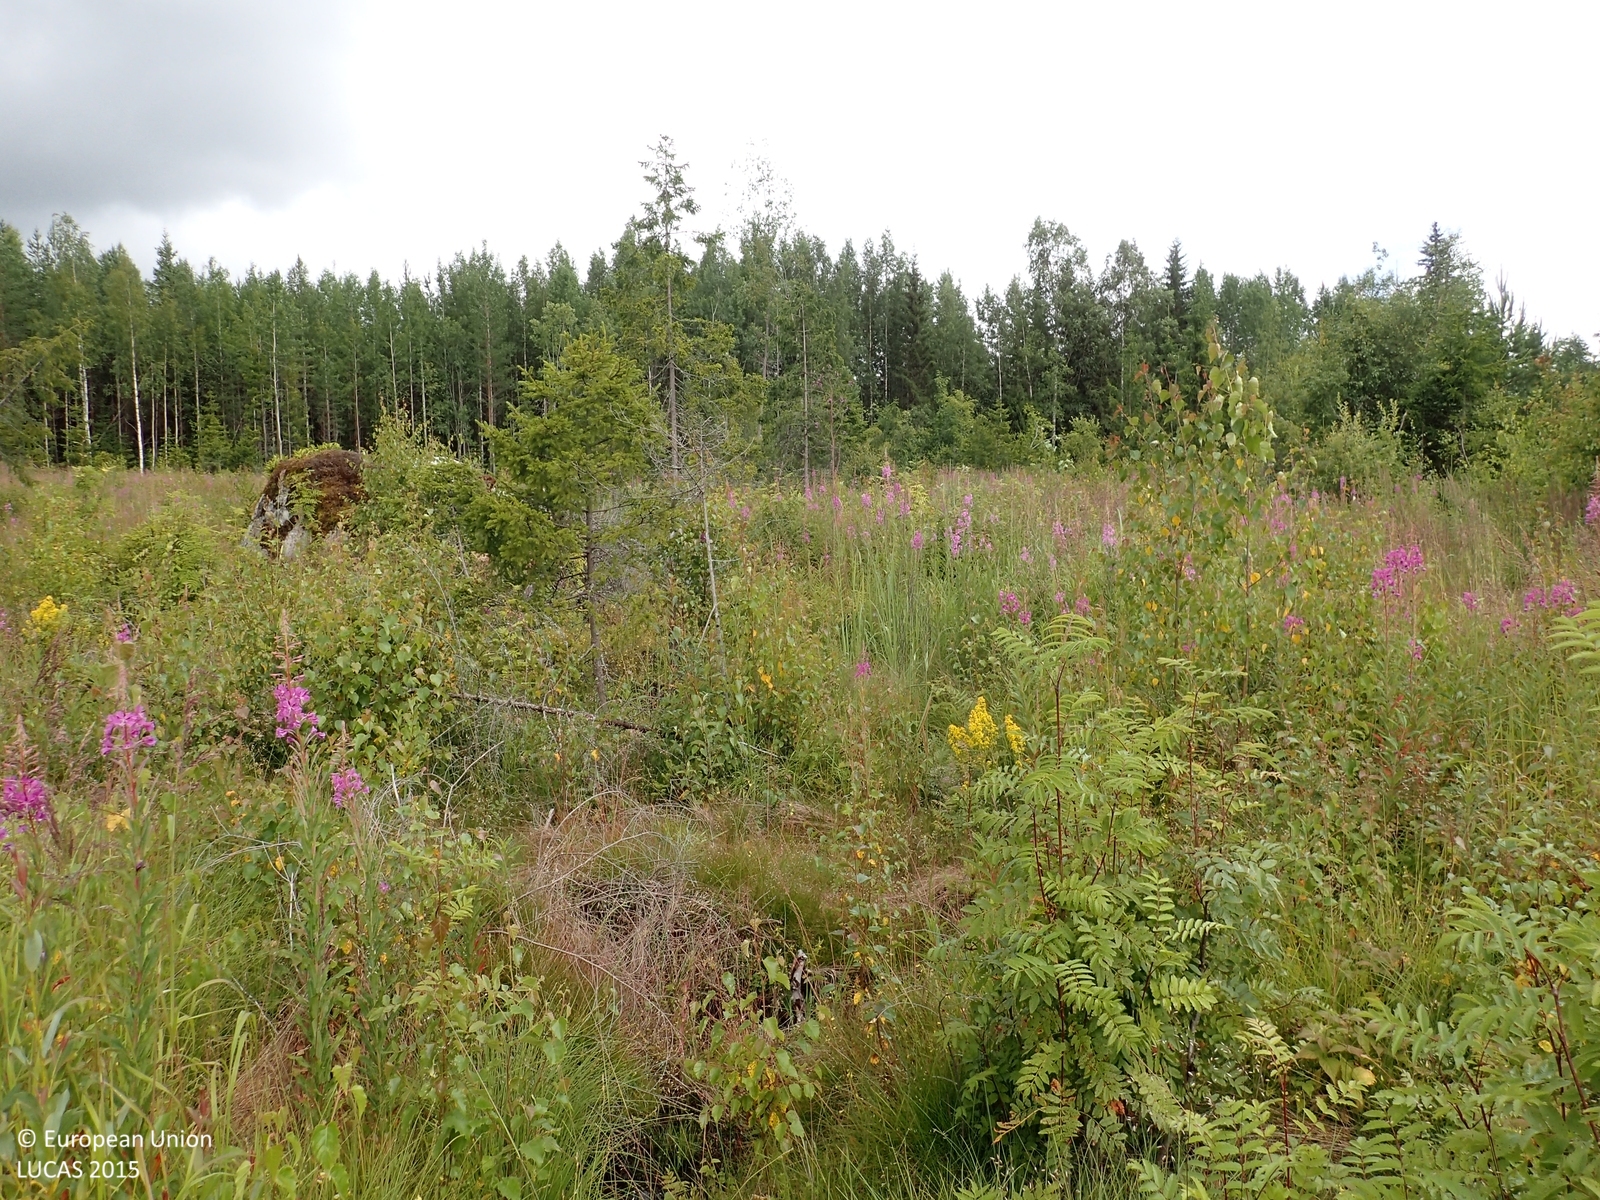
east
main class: Woodland
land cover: Spruce dominated mixed woodland
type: boreal forest
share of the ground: 10 - 25 %
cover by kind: herbaceous plants 85 %, broadleaved forest trees 10 %, coniferous forest trees 5 %
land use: Forestry
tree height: < 5 m
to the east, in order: Spruce dominated mixed woodland; Broadleaved woodland; Other mixed woodland; Tracks; Other mixed woodland; Pine dominated coniferous woodland
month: July
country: FI
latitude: 62.9839
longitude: 22.7433
